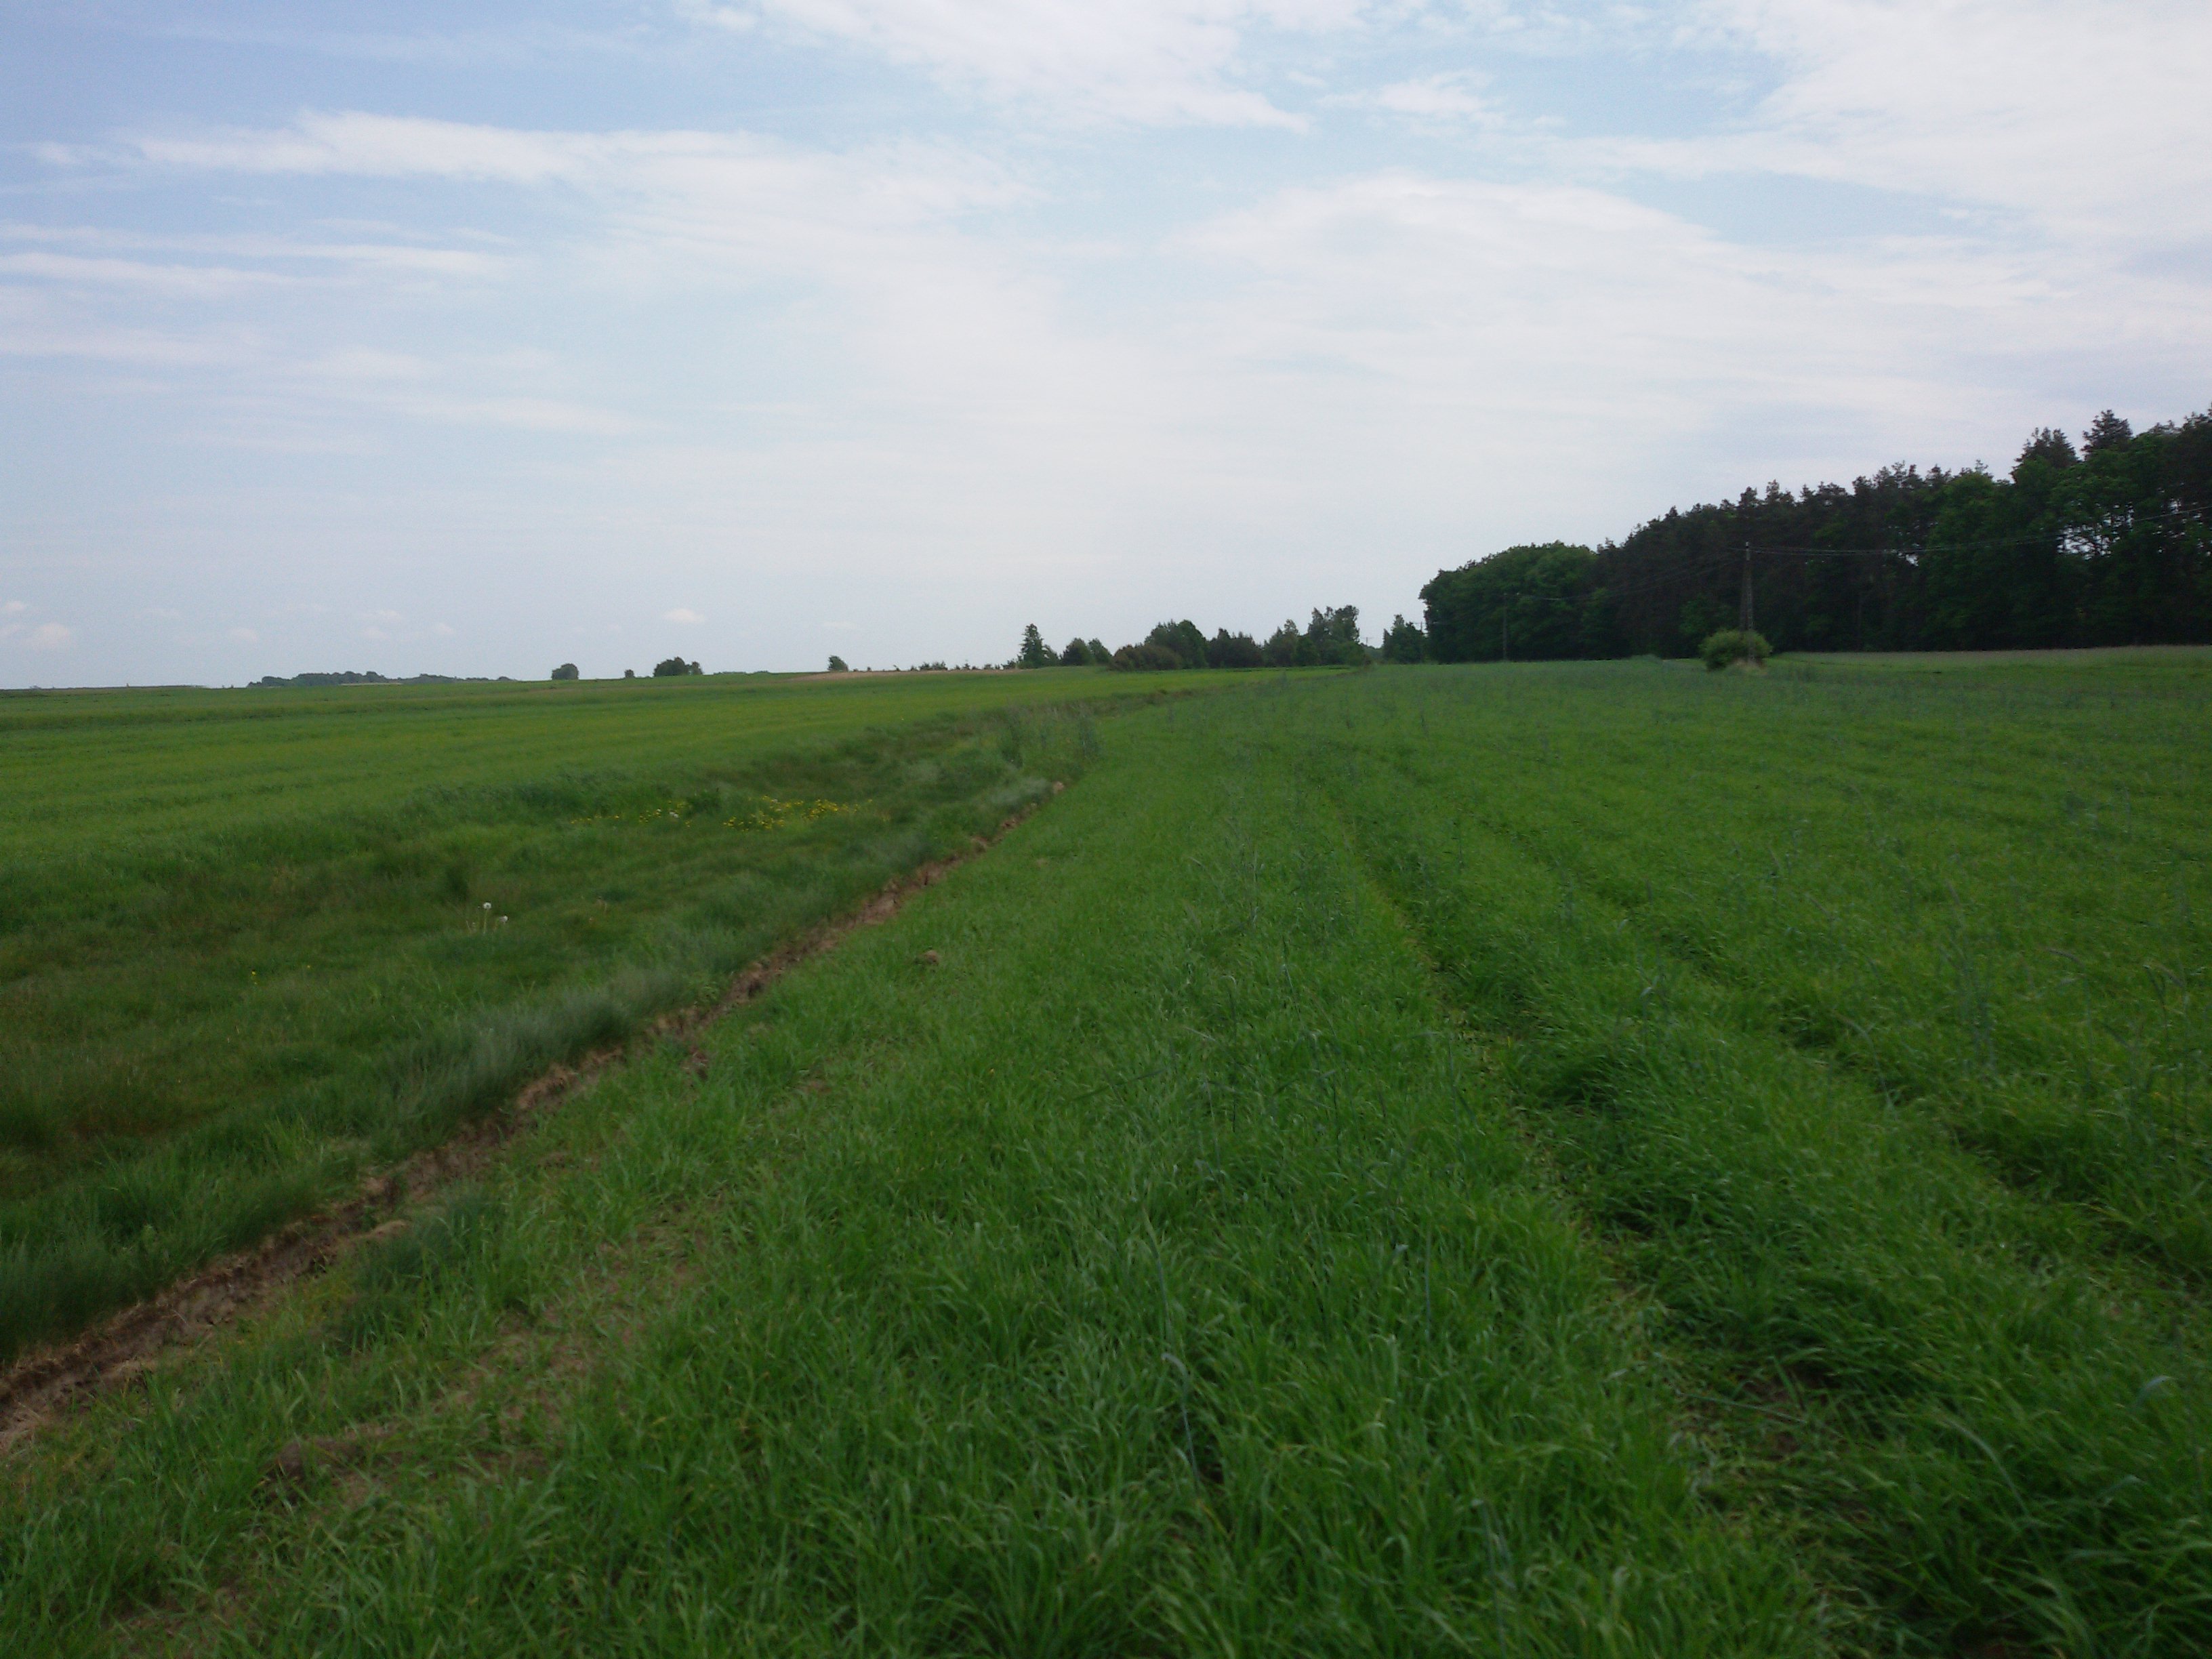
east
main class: Cropland
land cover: Triticale
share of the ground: 25 - 50 %
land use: Agriculture (excluding fallow land and kitchen gardens)
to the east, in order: Triticale; Tracks; Oats; Grass margins; Tracks; Grass margins; Mixed cereals for fodder
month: May
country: PL
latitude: 50.0749
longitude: 21.2957
